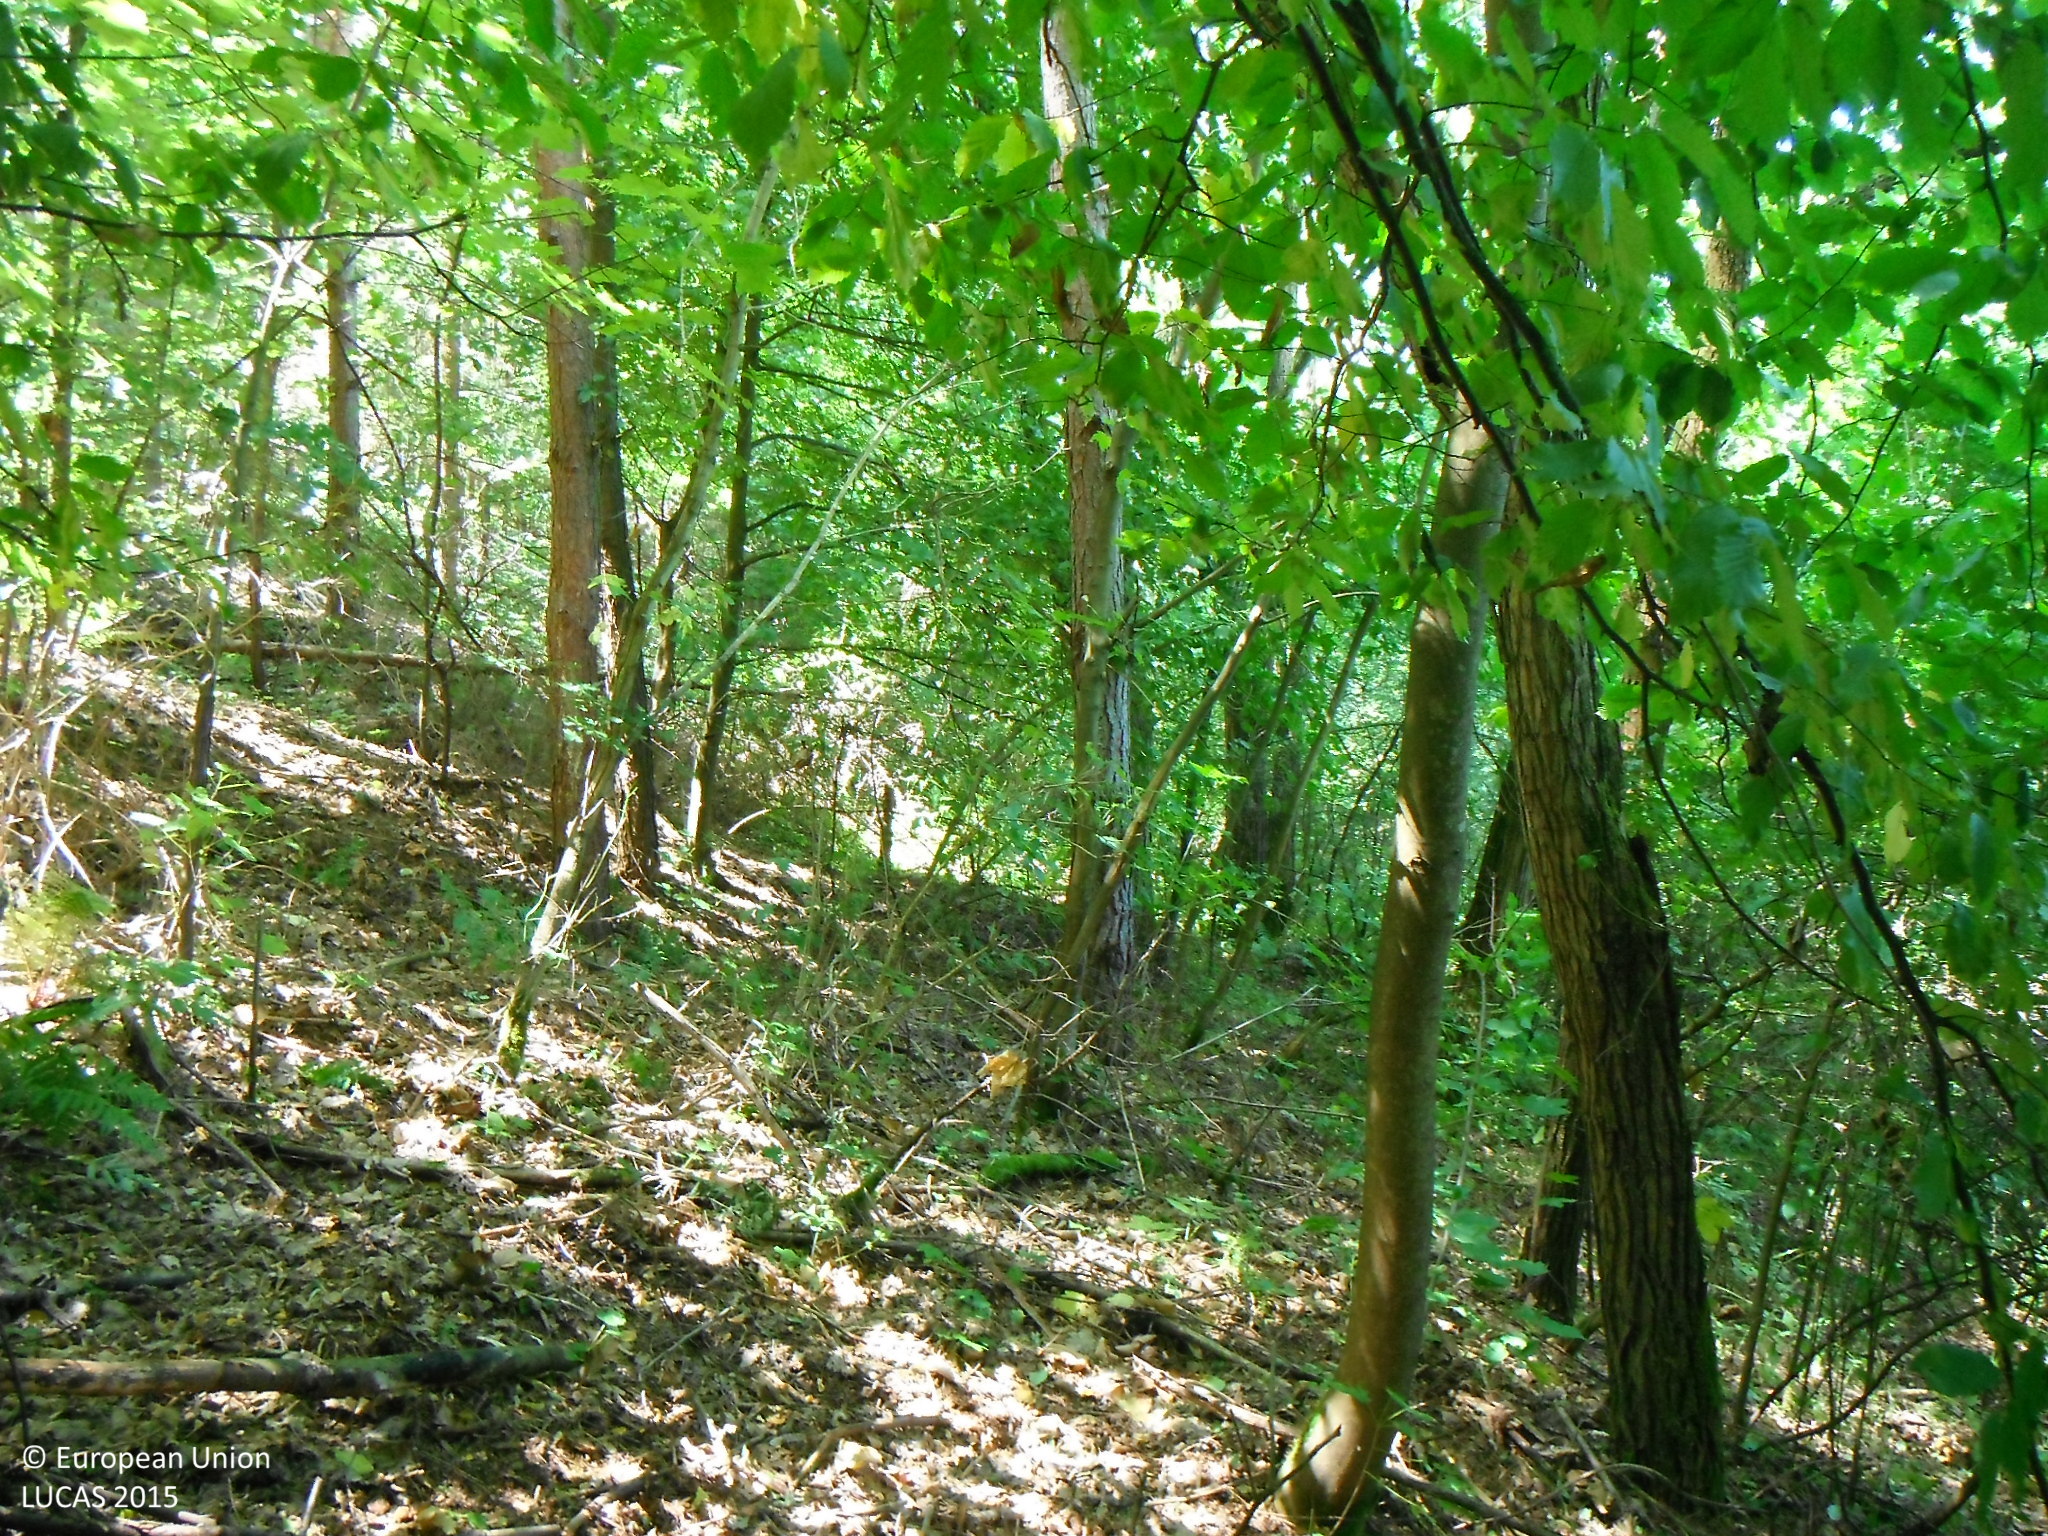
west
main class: Woodland
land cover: Broadleaved woodland
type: mesophytic deciduous forest
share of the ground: > 75 %
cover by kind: broadleaved forest trees 100 %
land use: Forestry
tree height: > 5 m
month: July
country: SK
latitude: 48.2005
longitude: 20.0257
